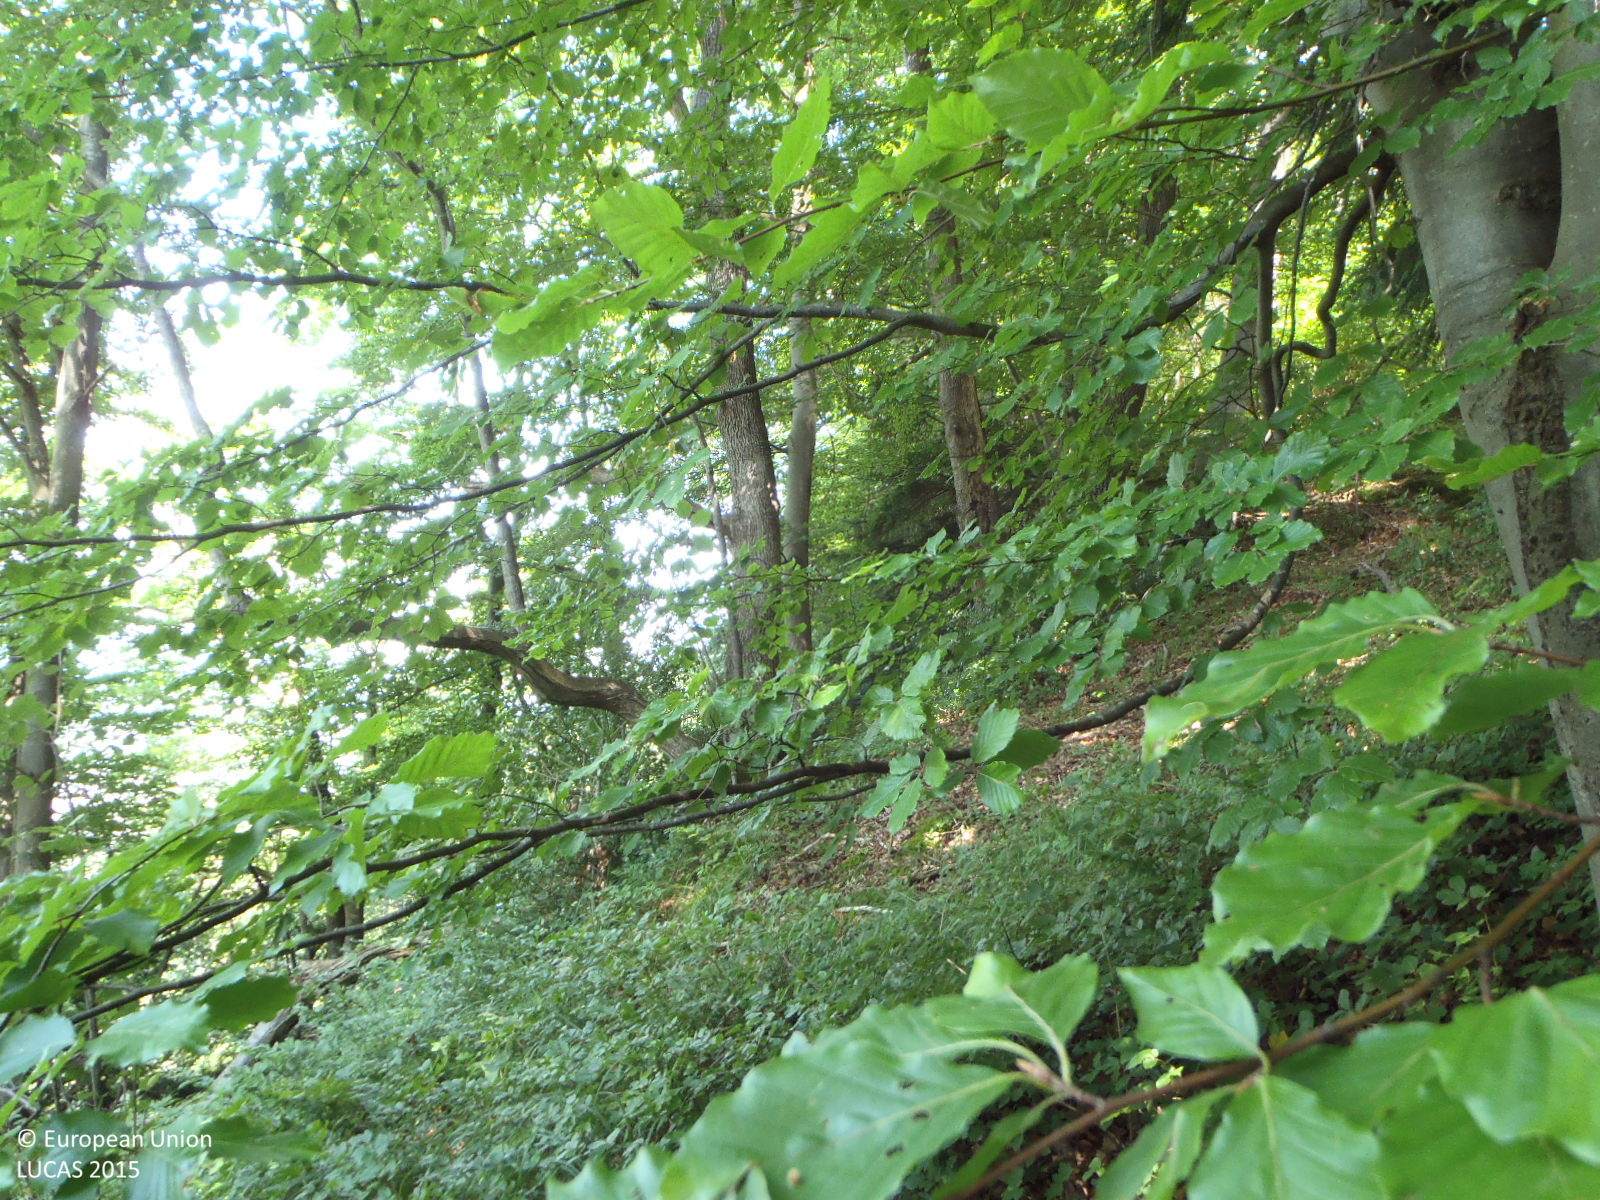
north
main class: Woodland
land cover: Broadleaved woodland
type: mountainous beech forest
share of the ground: > 75 %
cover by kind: broadleaved forest trees 80 %, coniferous forest trees 10 %, herbaceous plants 10 %
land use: Forestry
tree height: > 5 m
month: July
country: AT
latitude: 47.3411
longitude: 9.6694
